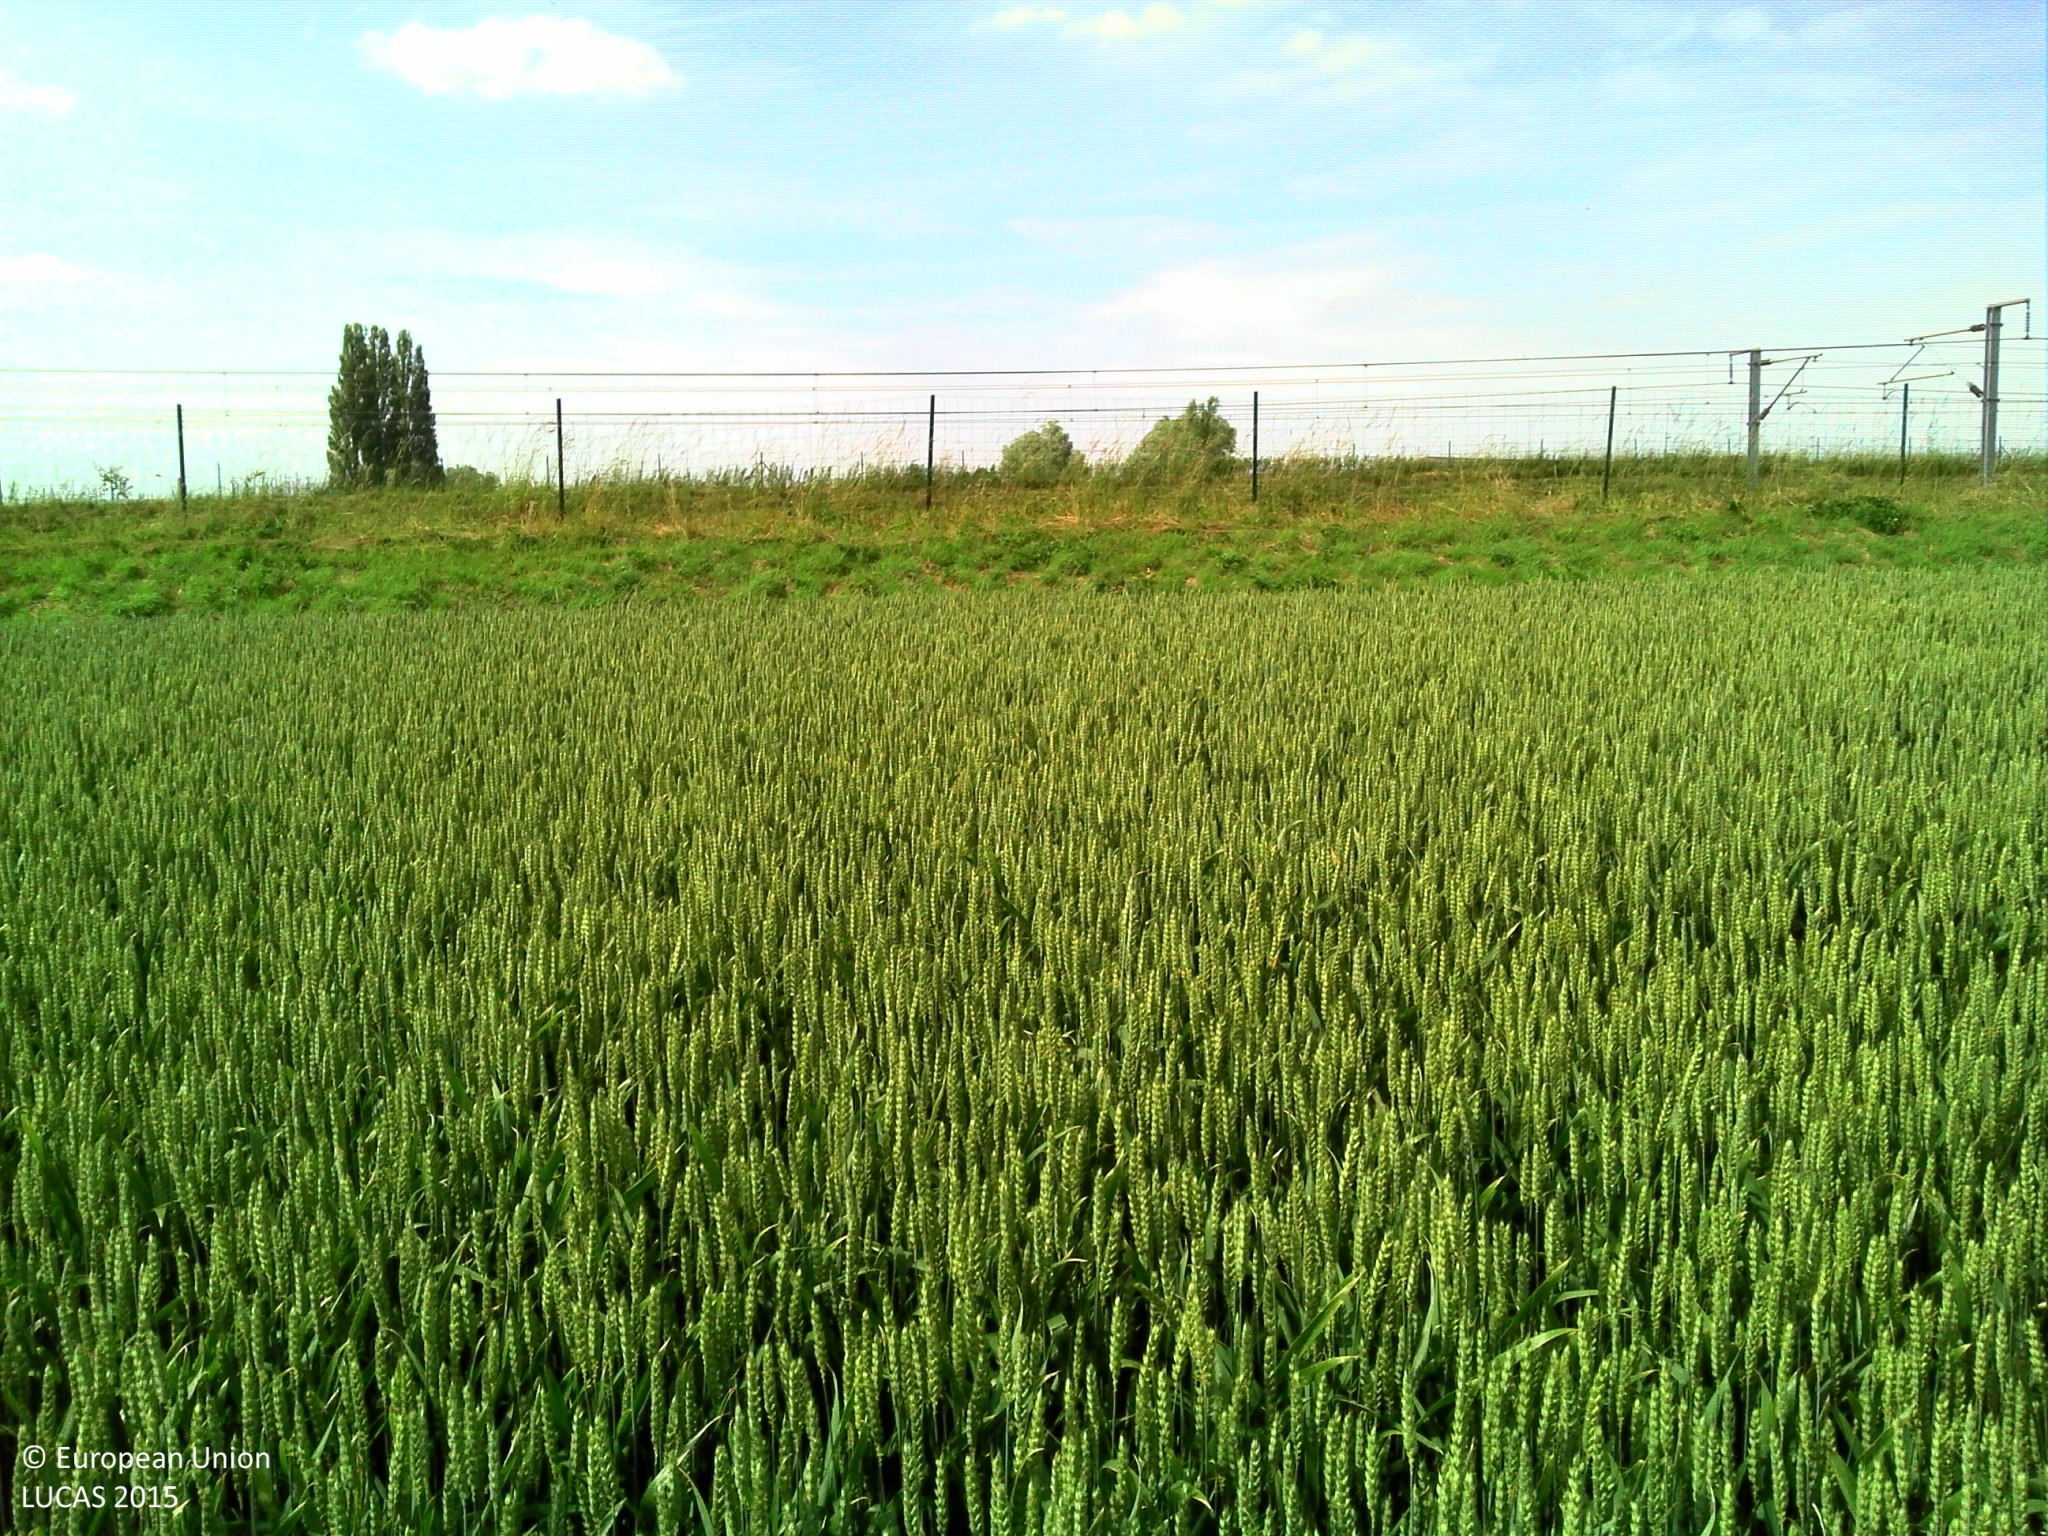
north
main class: Cropland
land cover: Common wheat
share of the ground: > 75 %
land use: Agriculture (excluding fallow land and kitchen gardens)
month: June
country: BE
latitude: 50.5682
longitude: 3.6819
